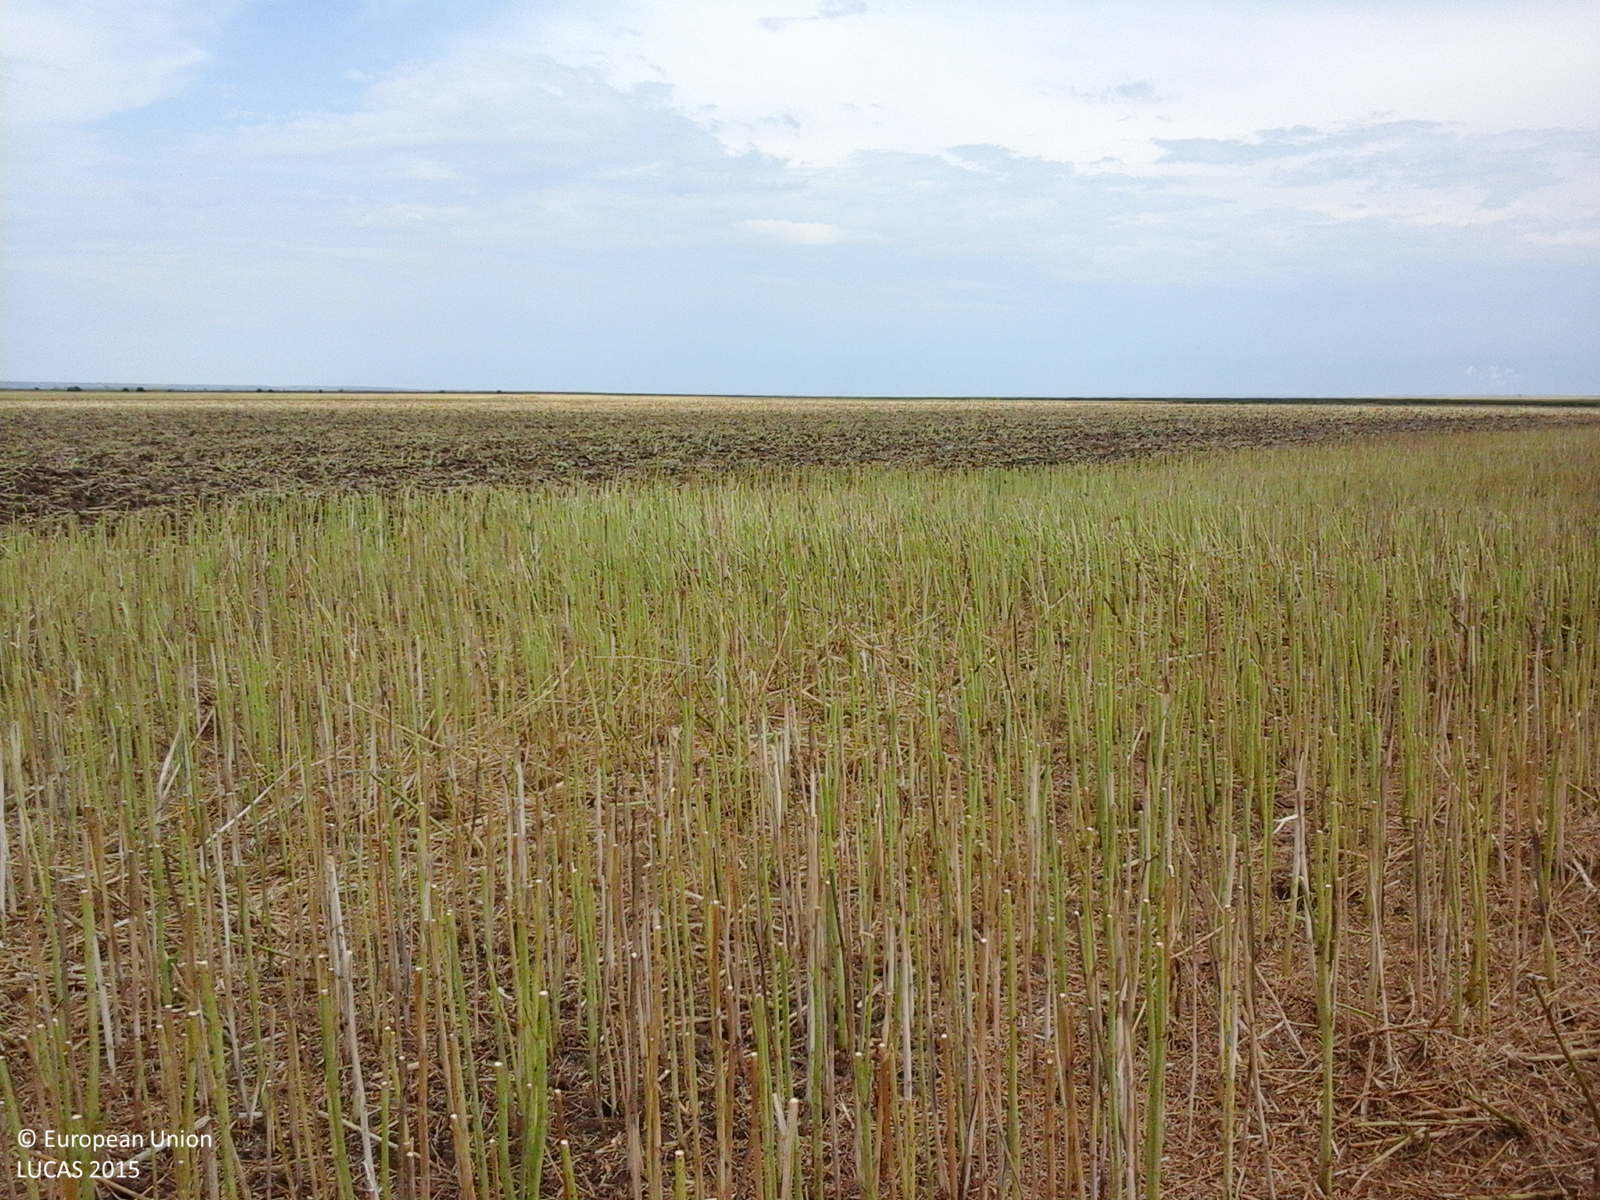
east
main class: Cropland
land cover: Rape and turnip rape
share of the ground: < 10 %
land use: Agriculture (excluding fallow land and kitchen gardens)
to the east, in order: Rape and turnip rape
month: July
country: RO
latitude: 43.8871
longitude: 24.5424
